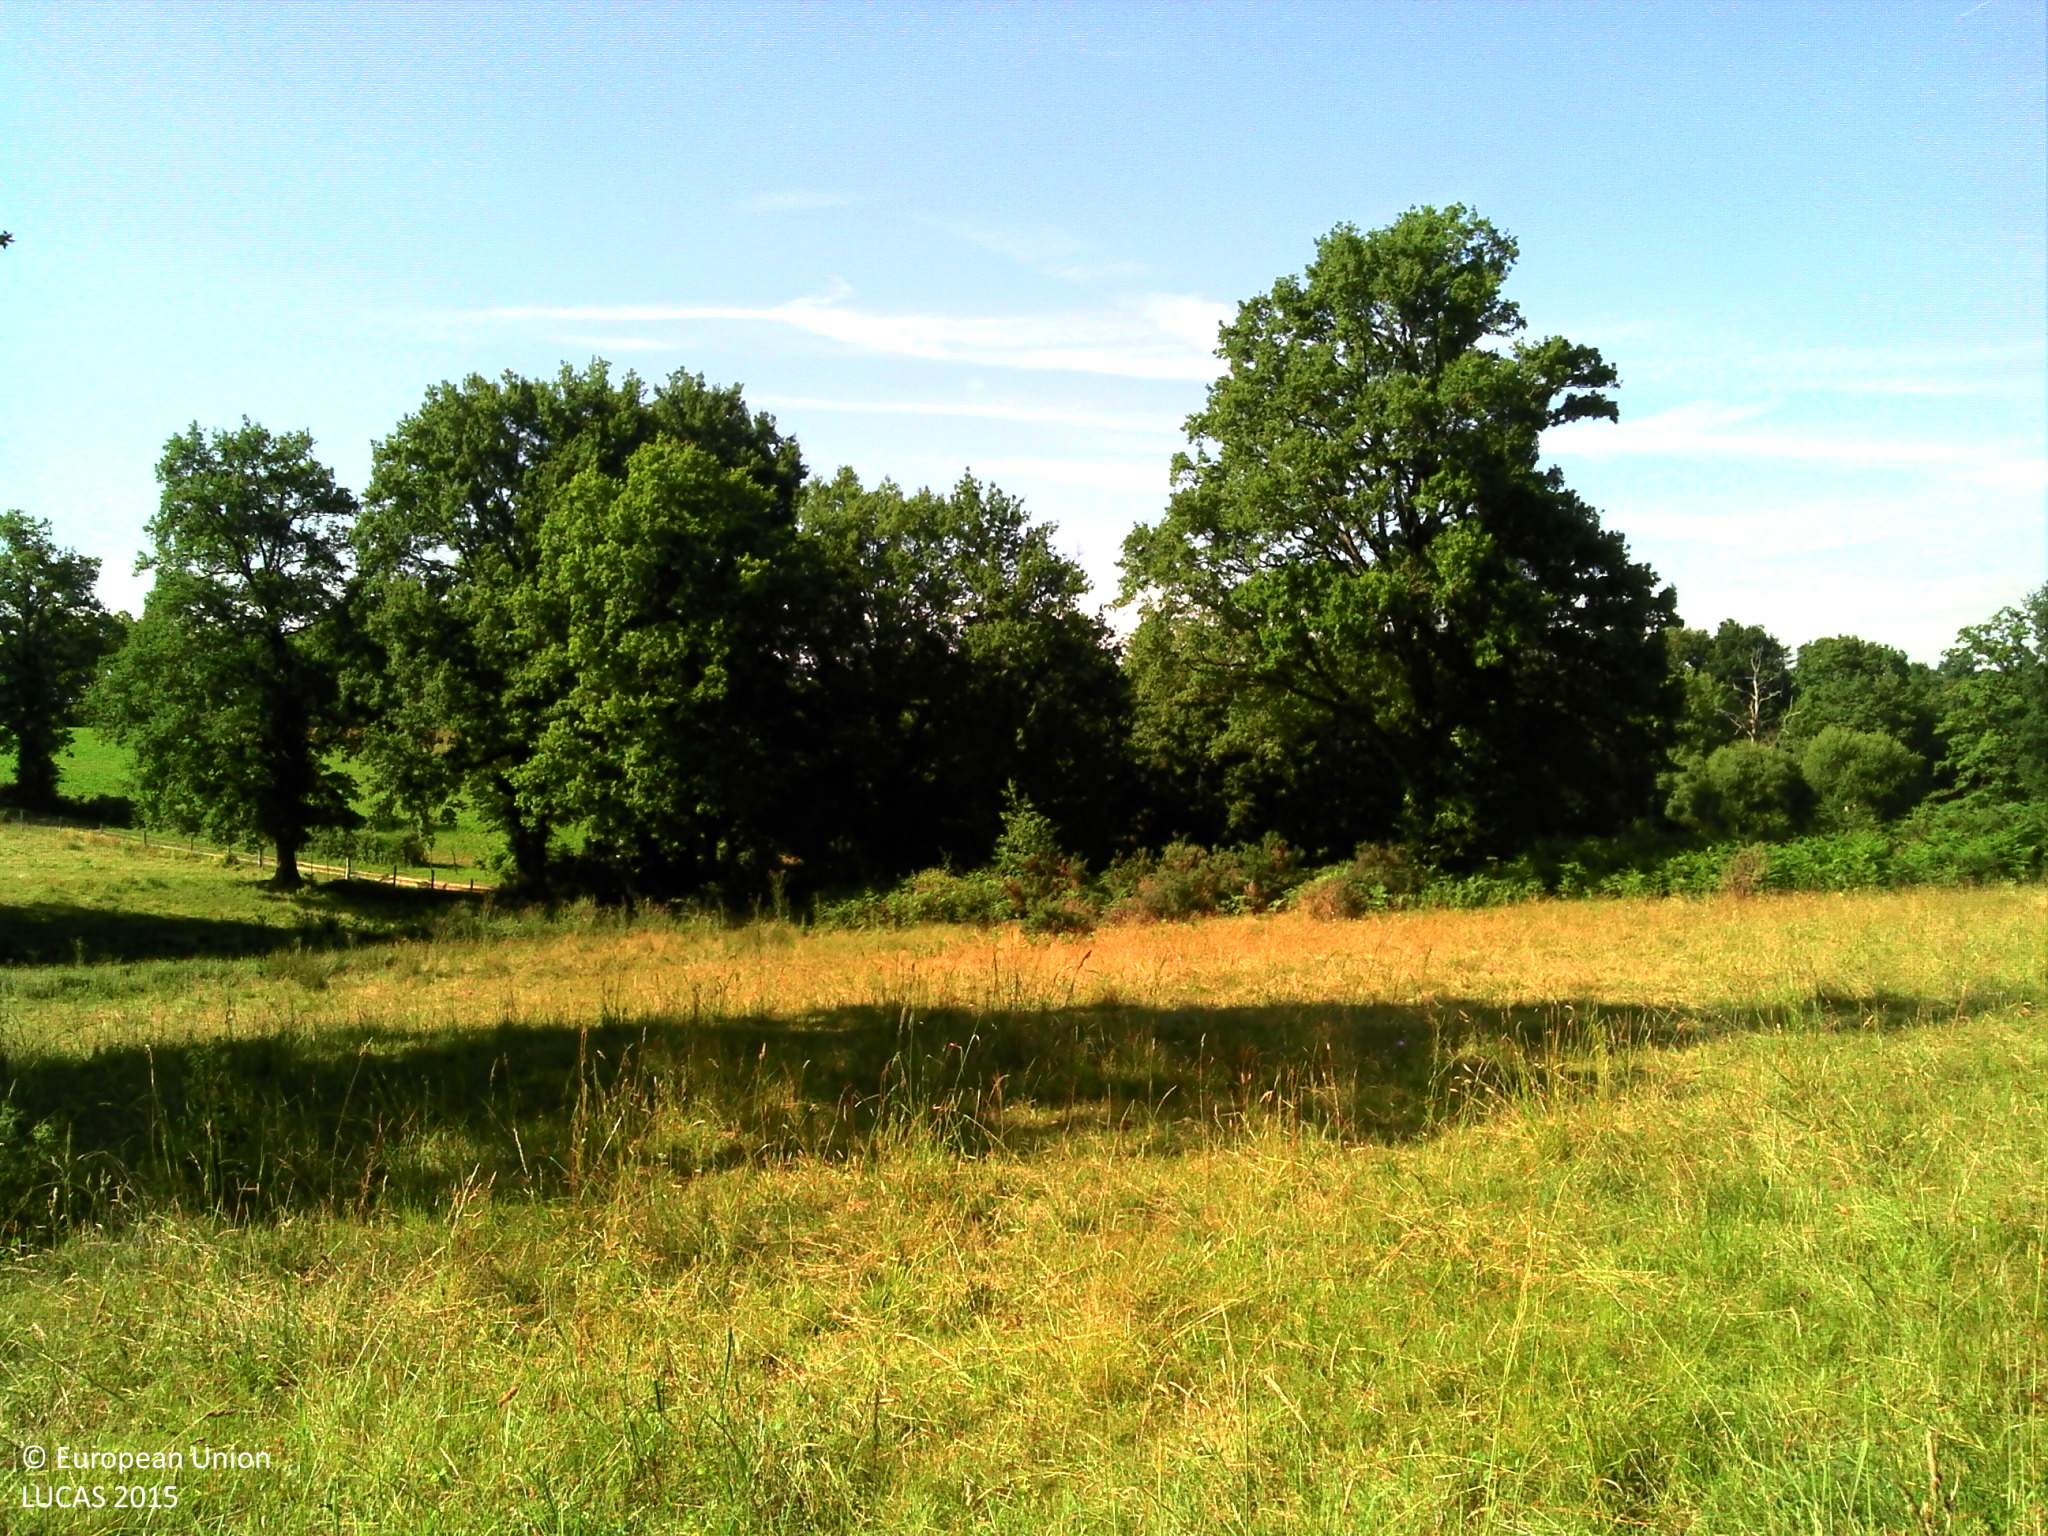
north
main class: Grassland
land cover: Grassland with sparse tree/shrub cover
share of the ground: > 75 %
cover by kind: herbaceous plants 95 %, broadleaved forest trees 5 %
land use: Agriculture (excluding fallow land and kitchen gardens)
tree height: > 5 m
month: June
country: FR
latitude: 45.8168
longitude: 0.6819
